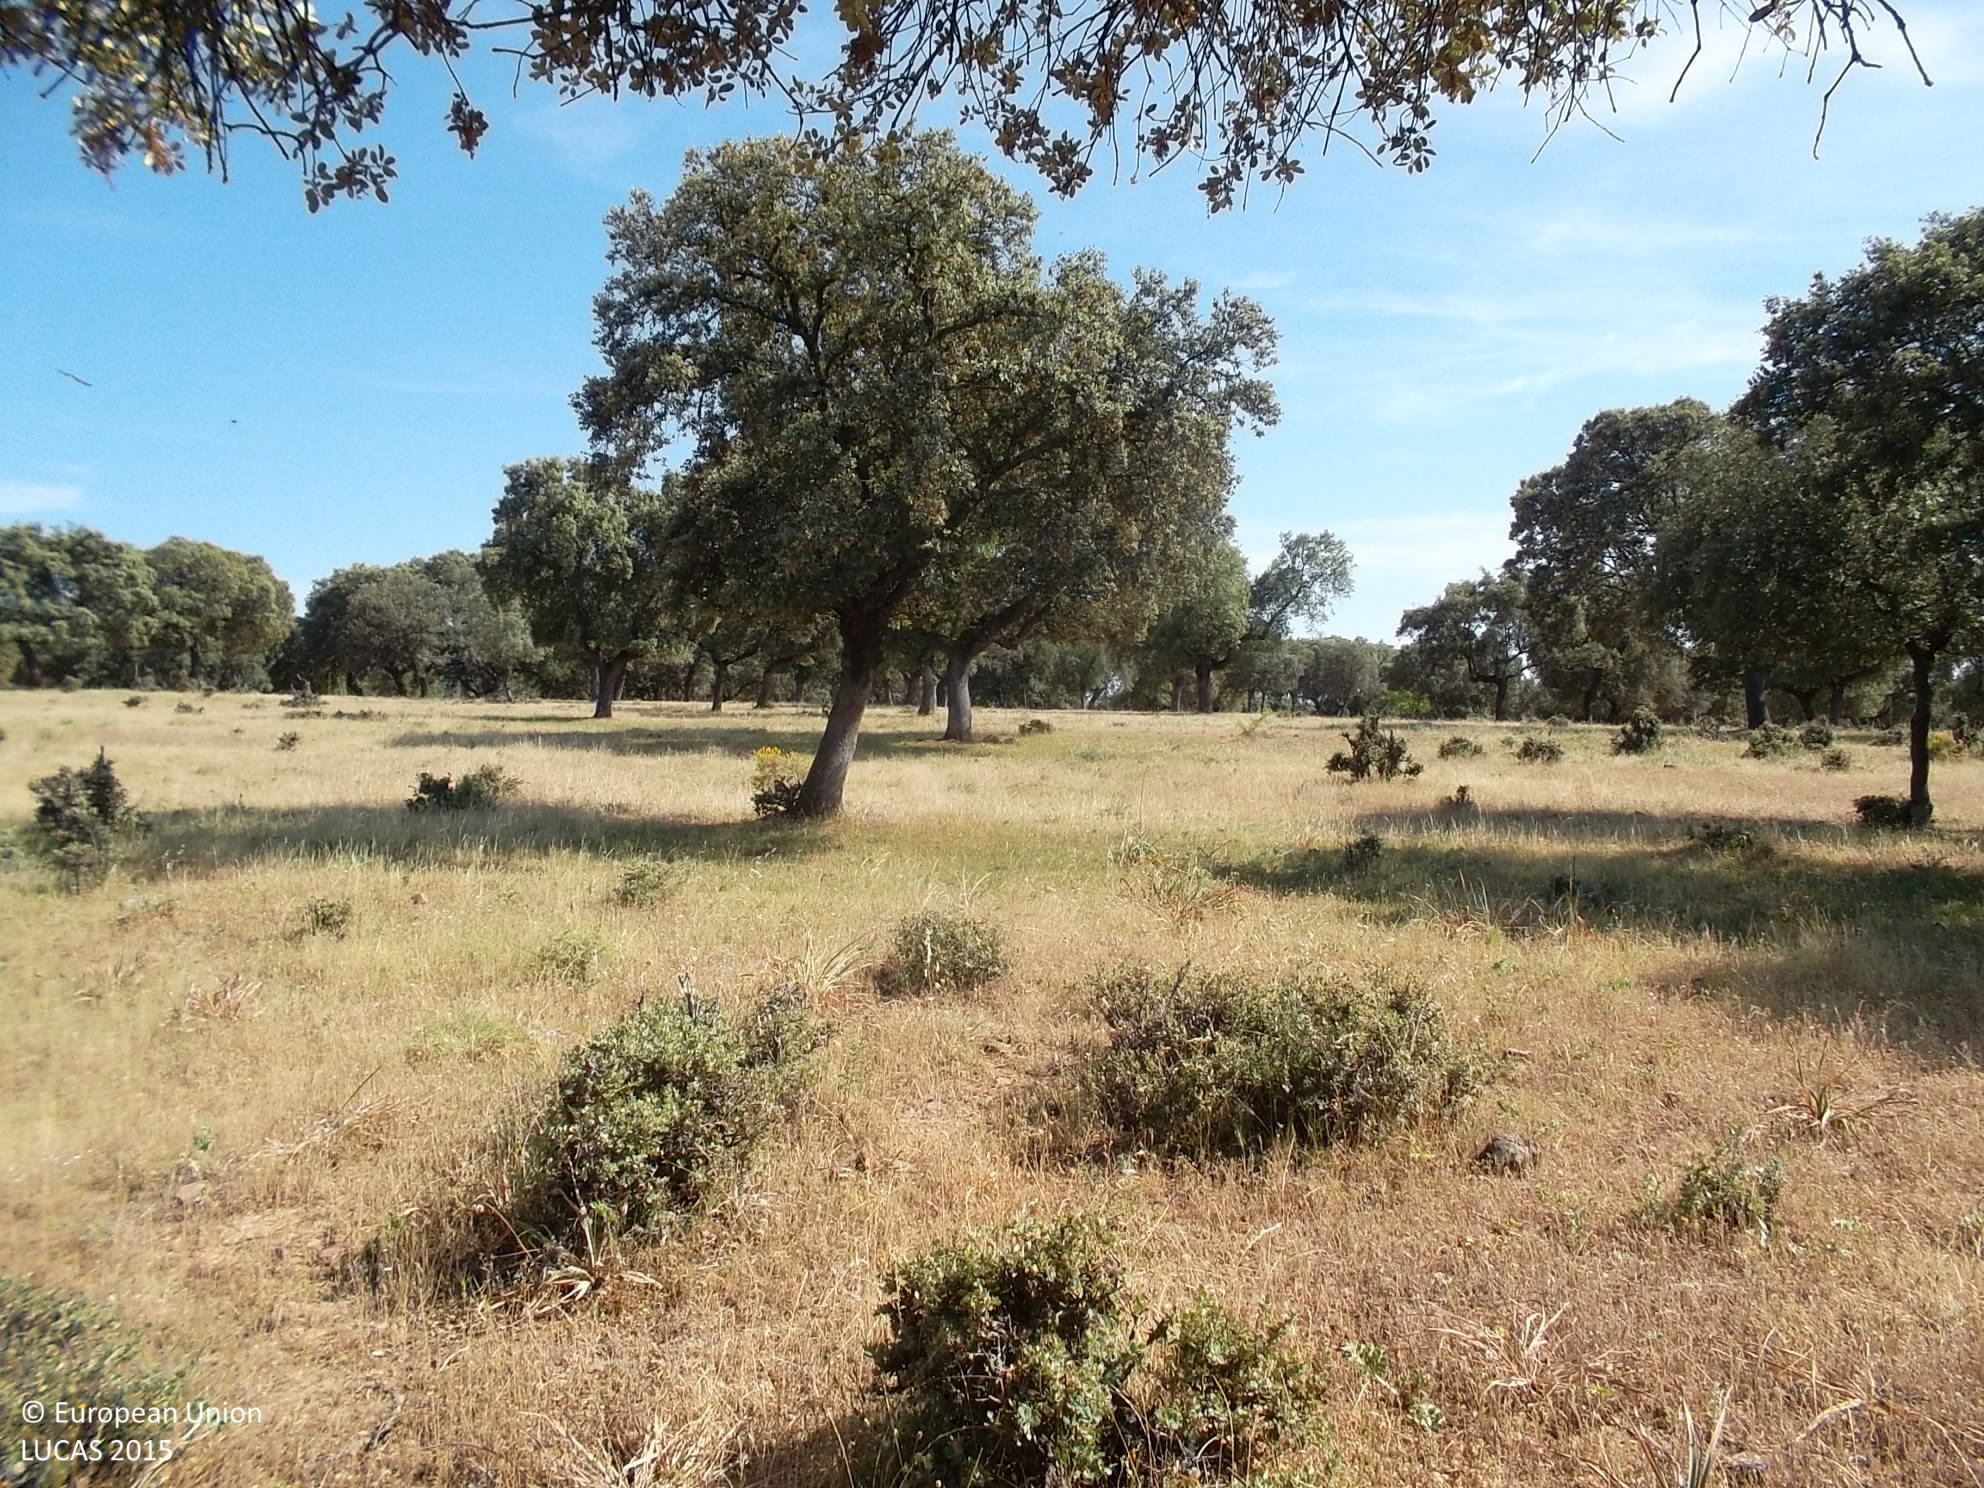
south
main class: Woodland
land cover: Broadleaved woodland
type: broadleaved evergreen forest
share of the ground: 25 - 50 %
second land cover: Spontaneously vegetated surfaces
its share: > 75 %
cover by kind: herbaceous plants 60 %, broadleaved forest trees 40 %
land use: Forestry
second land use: Agriculture (excluding fallow land and kitchen gardens)
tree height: > 5 m
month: May
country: ES
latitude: 38.7985
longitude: -4.4984
